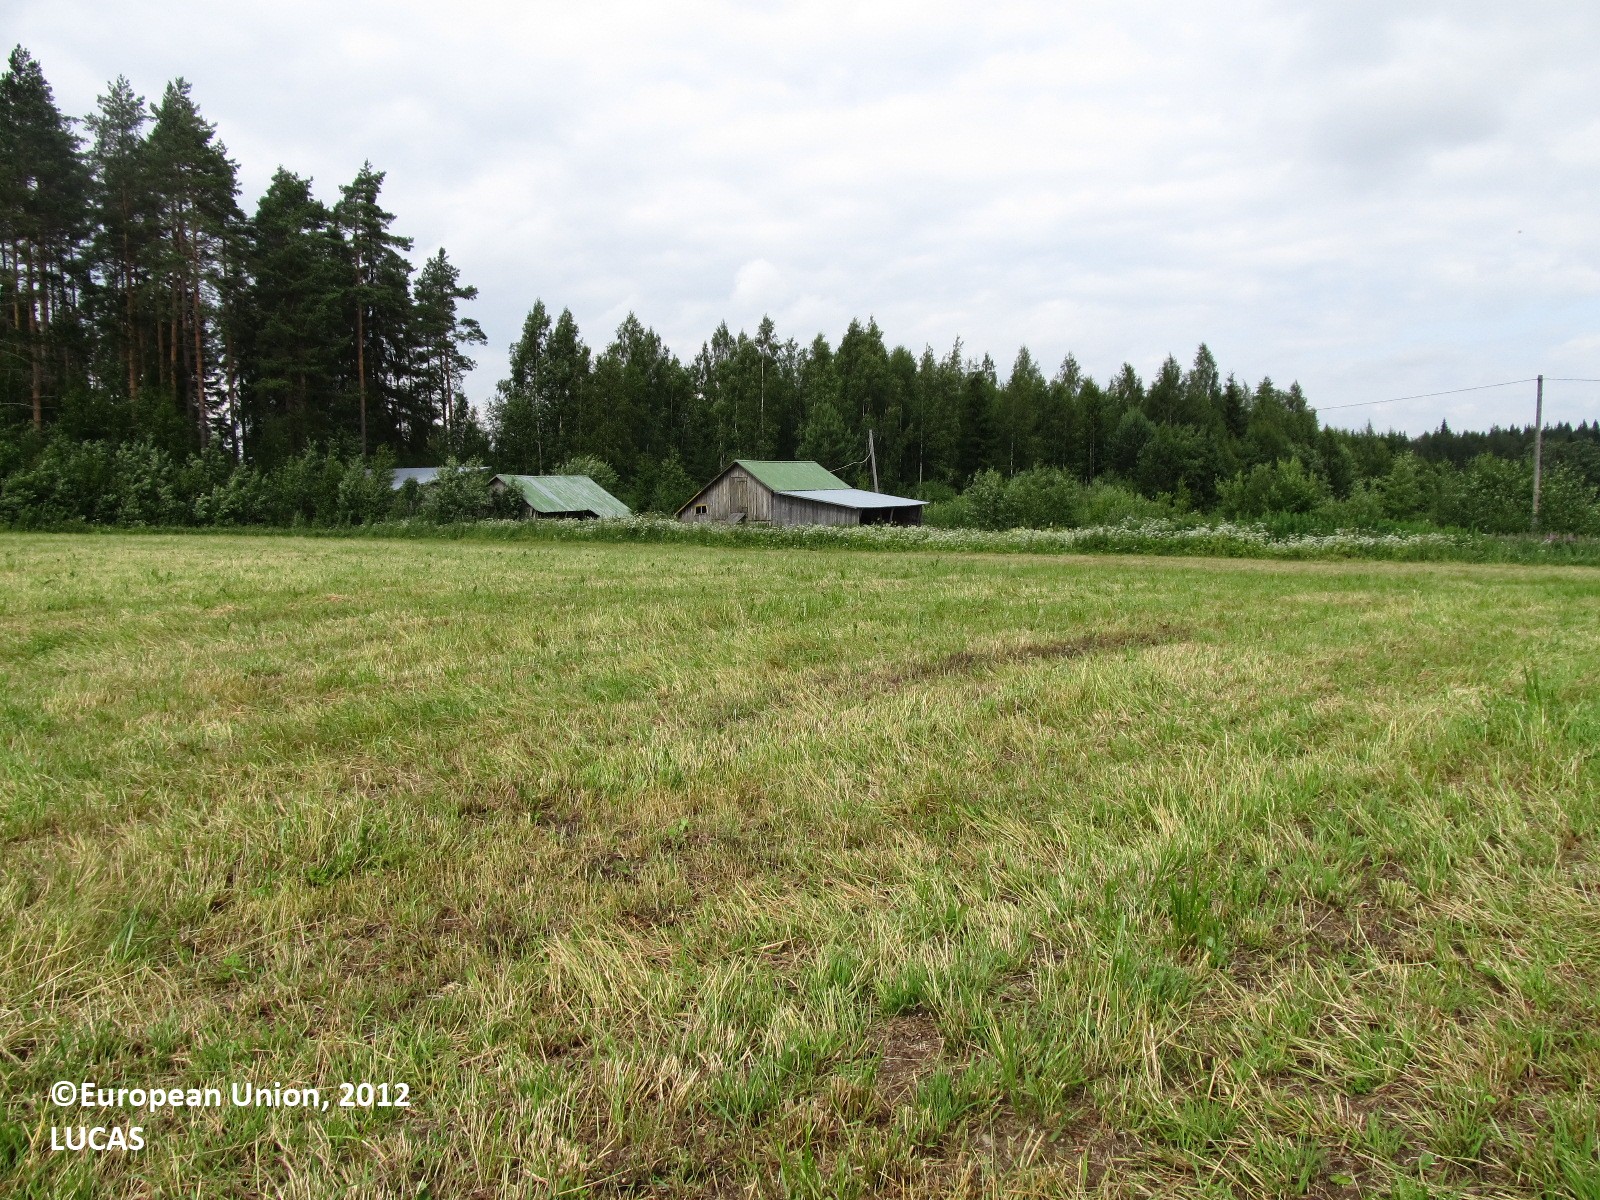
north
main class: Grassland
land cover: Grassland without tree/shrub cover
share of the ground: 50 - 75 %
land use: Fallow land
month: July
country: FI
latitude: 61.9196
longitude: 28.3113
